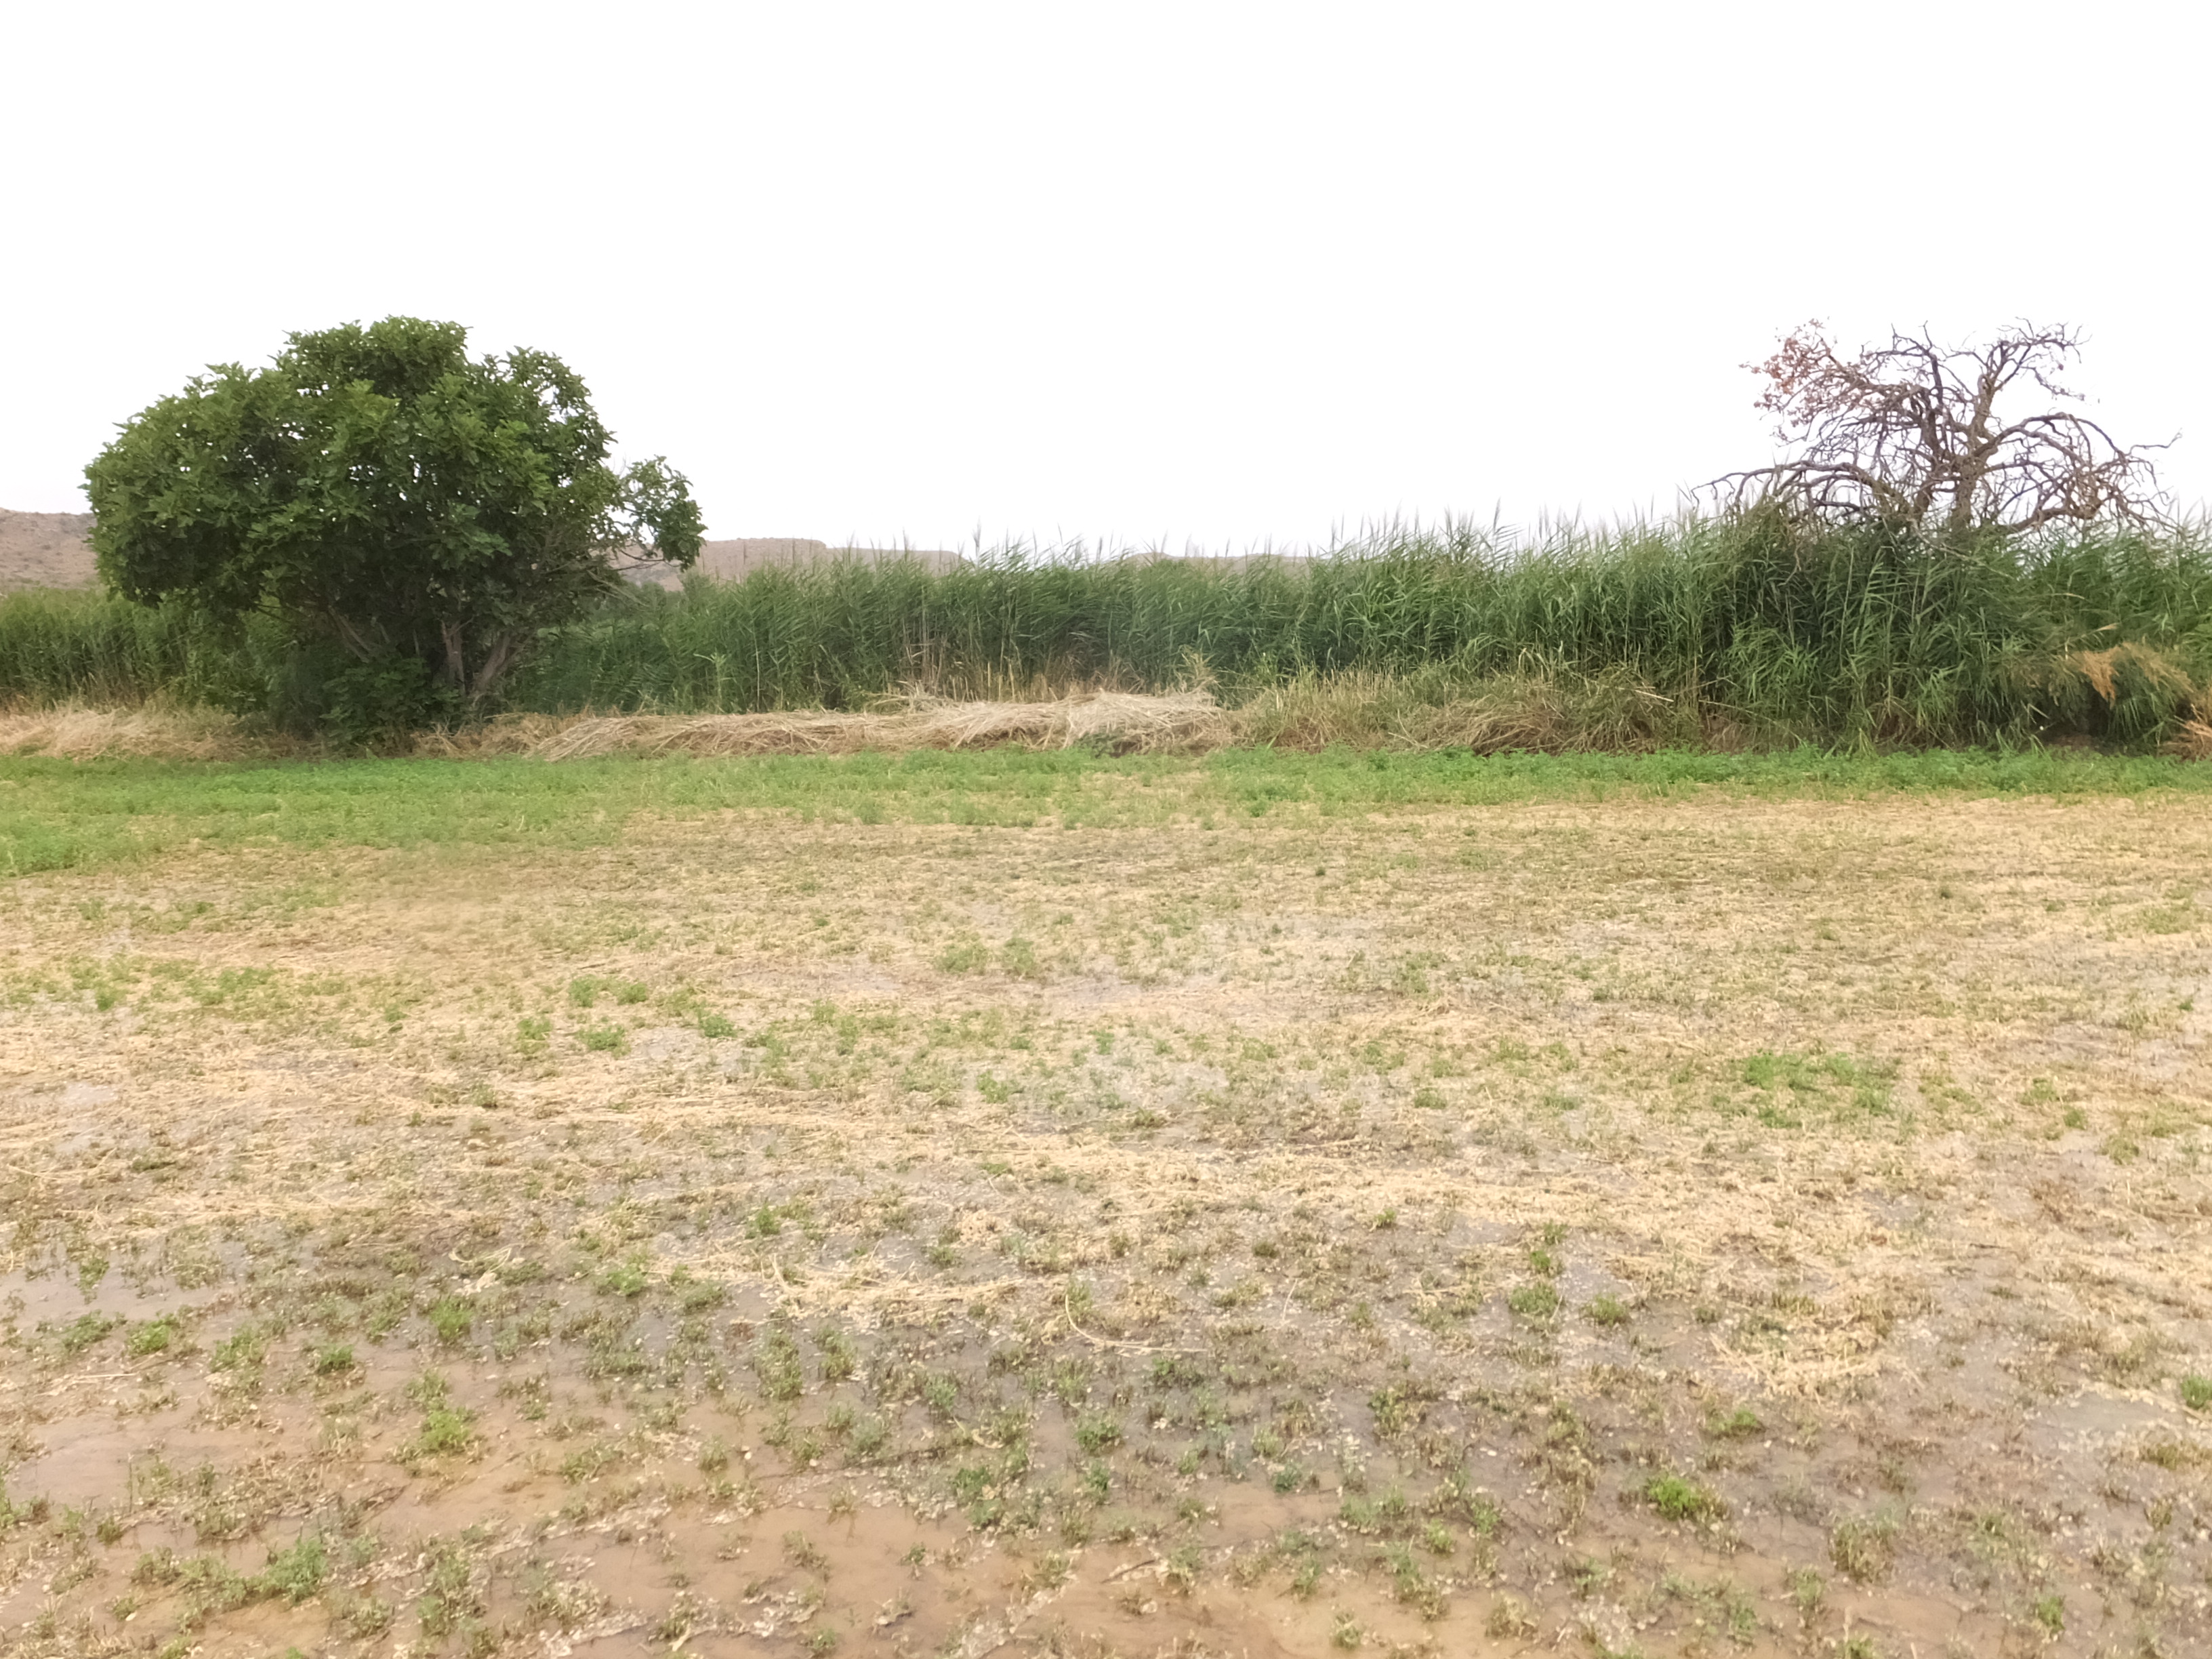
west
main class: Cropland
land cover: Lucerne
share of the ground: > 75 %
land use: Agriculture (excluding fallow land and kitchen gardens)
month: July
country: ES
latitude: 41.6635
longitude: 0.1489
